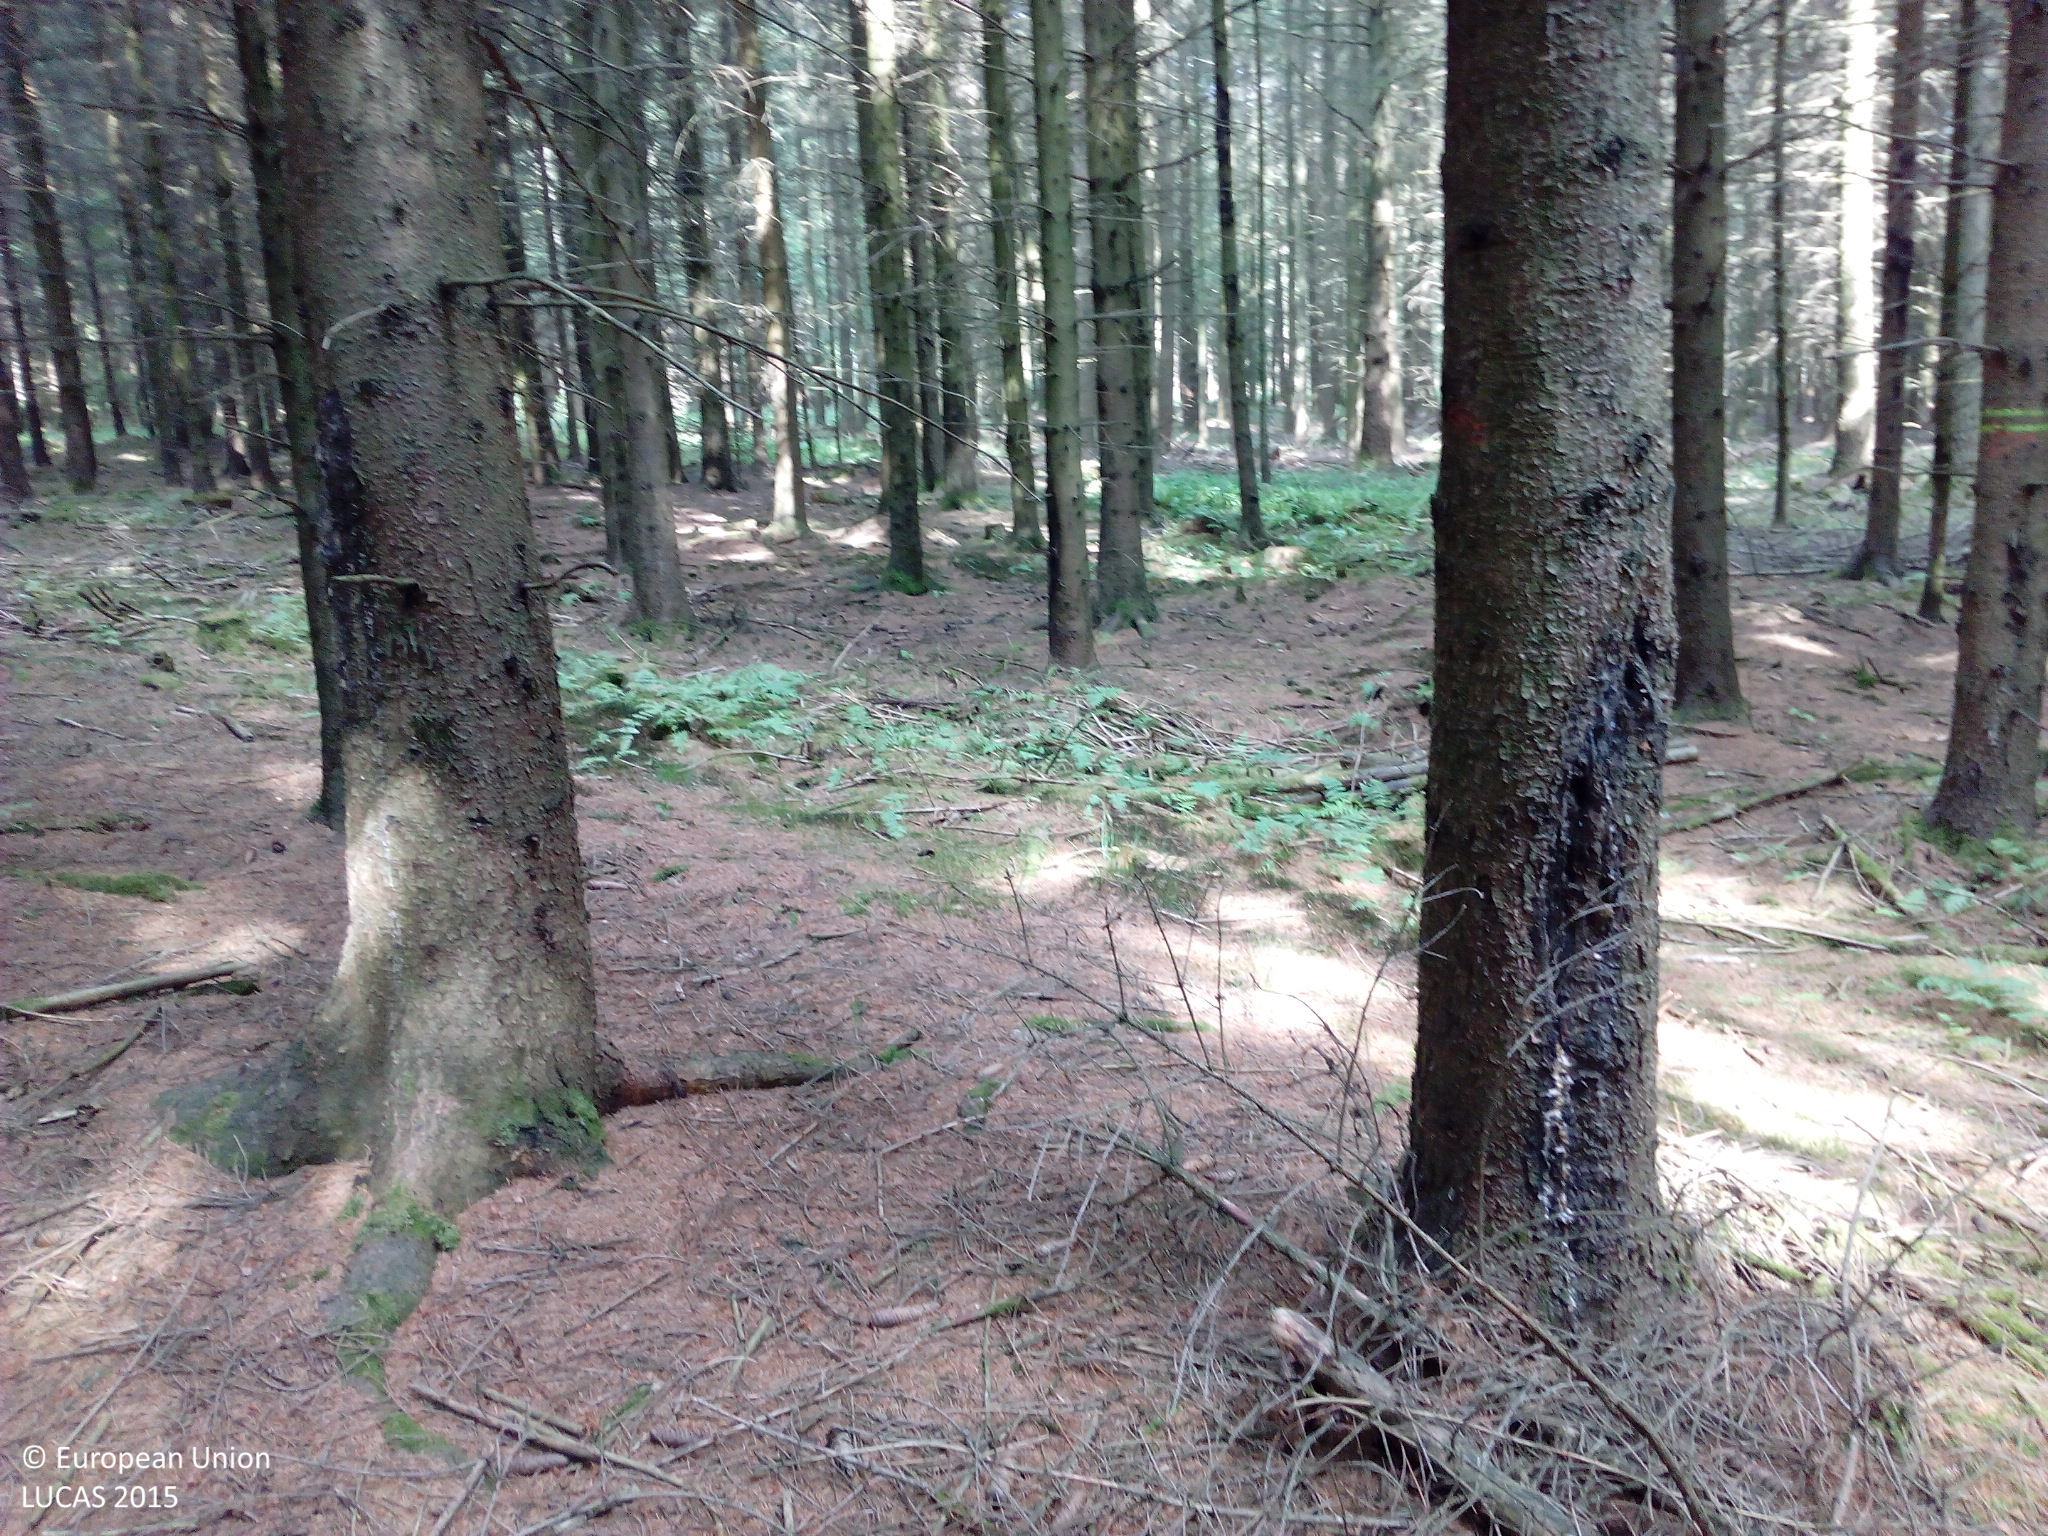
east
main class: Woodland
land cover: Spruce dominated coniferous woodland
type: hemiboreal forest and nemoral coniferous forest and mixed broadleaved-coniferous forest
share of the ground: > 75 %
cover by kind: coniferous forest trees 100 %
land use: Forestry
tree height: > 5 m
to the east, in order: Spruce dominated coniferous woodland; Rivers and streams; Spruce dominated coniferous woodland; Tracks; Grass margins; Ditches and canals; Spruce dominated coniferous woodland; Tracks; Spruce dominated coniferous woodland; Broadleaved woodland
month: July
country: DE
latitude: 49.6624
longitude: 7.1325
